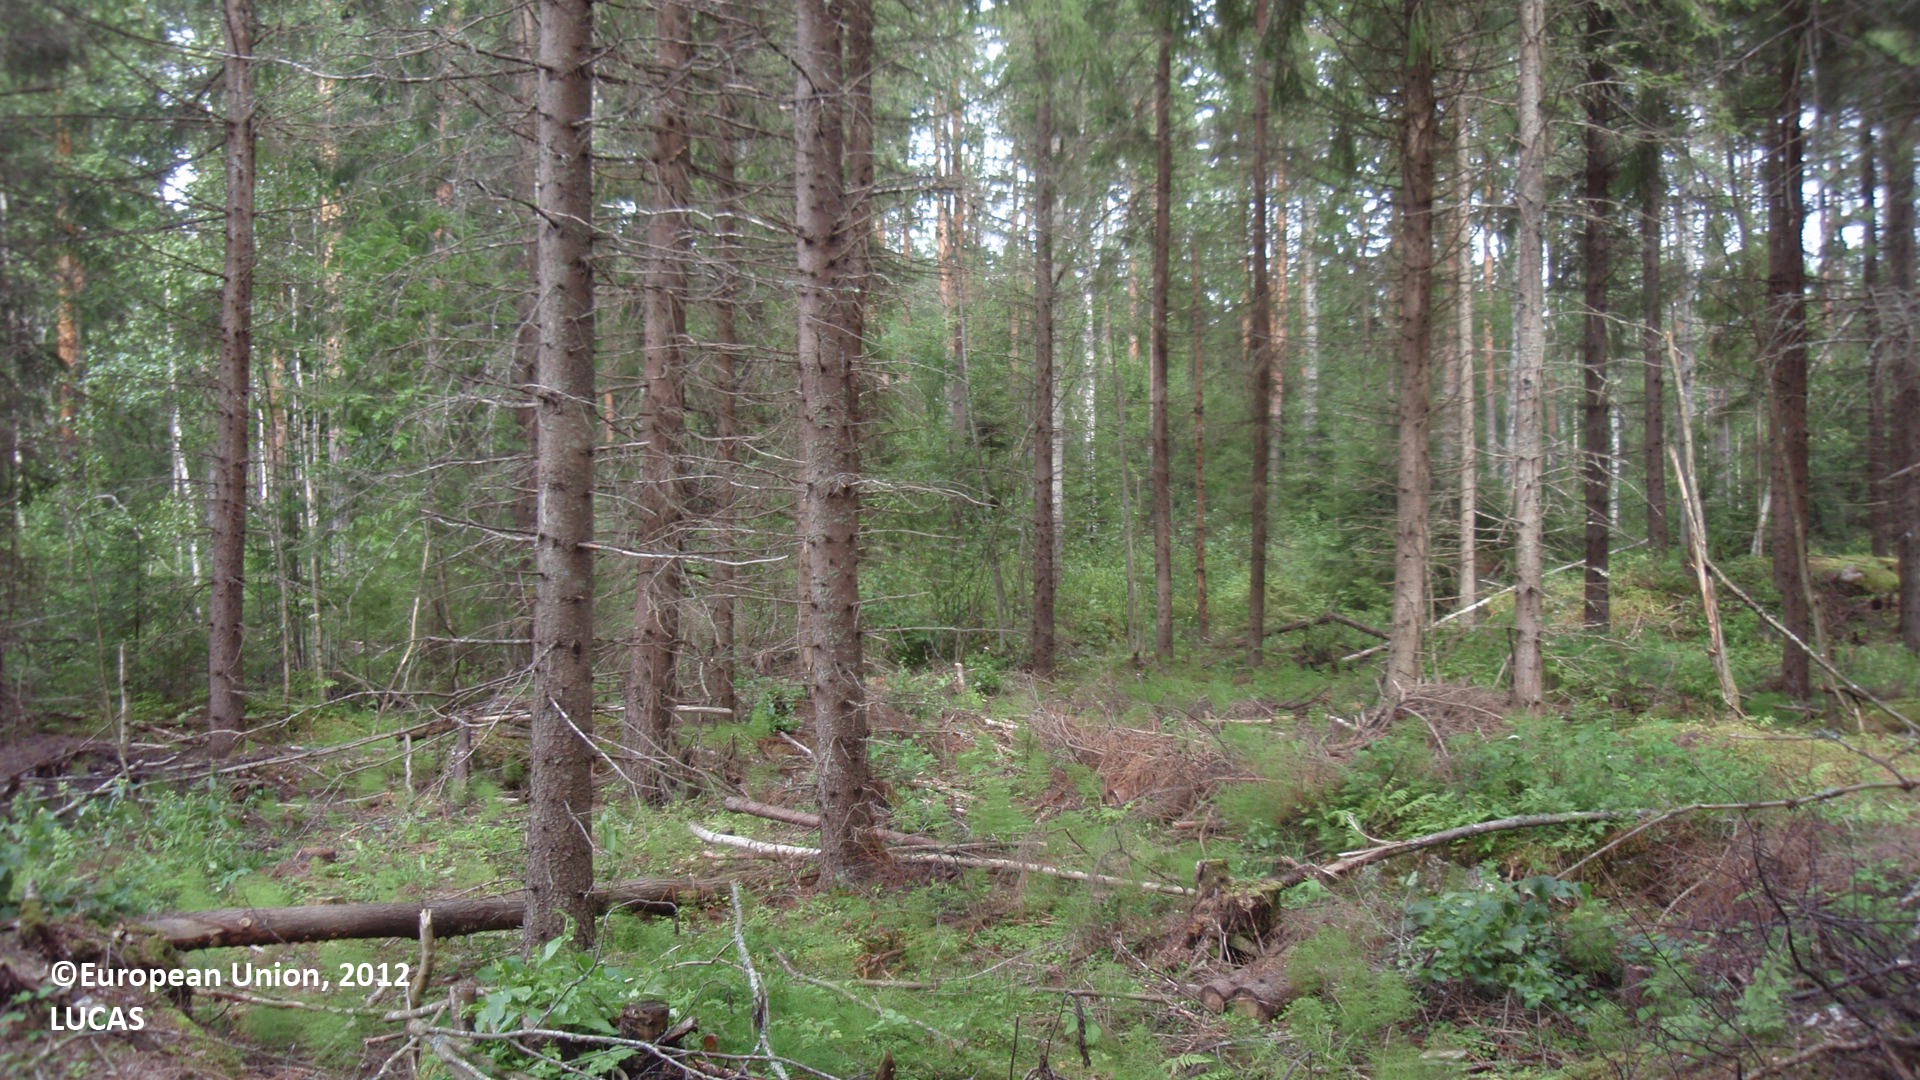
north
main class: Woodland
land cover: Spruce dominated coniferous woodland
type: boreal forest
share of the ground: 50 - 75 %
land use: Forestry
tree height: > 5 m
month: August
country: FI
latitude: 61.0369
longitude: 27.6437
